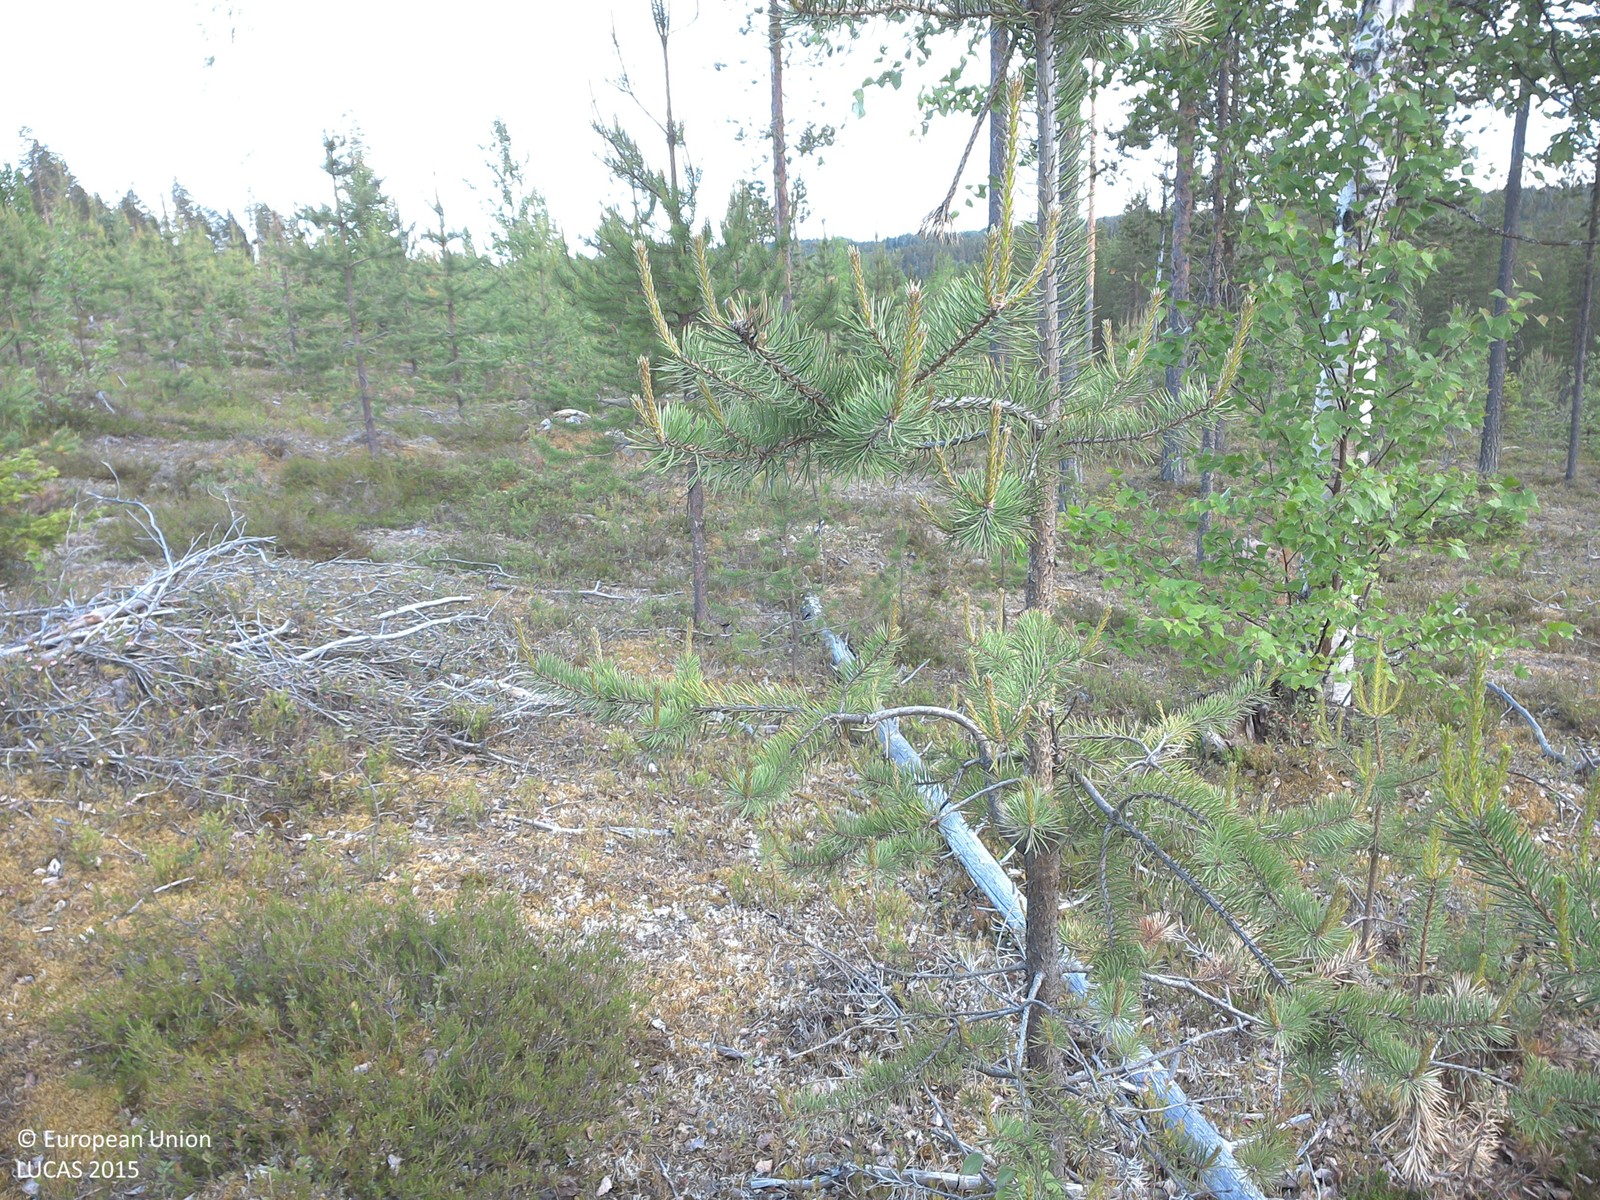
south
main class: Woodland
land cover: Pine dominated mixed woodland
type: exotic forest
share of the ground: 25 - 50 %
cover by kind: shrubs 30 %, unconsolidated bare surface 25 %, coniferous forest trees 20 %, lichens and mosses 15 %, broadleaved forest trees 10 %
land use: Forestry
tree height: < 5 m
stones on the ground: 10 - 25 %
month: July
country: SE
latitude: 67.2370
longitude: 23.3345
